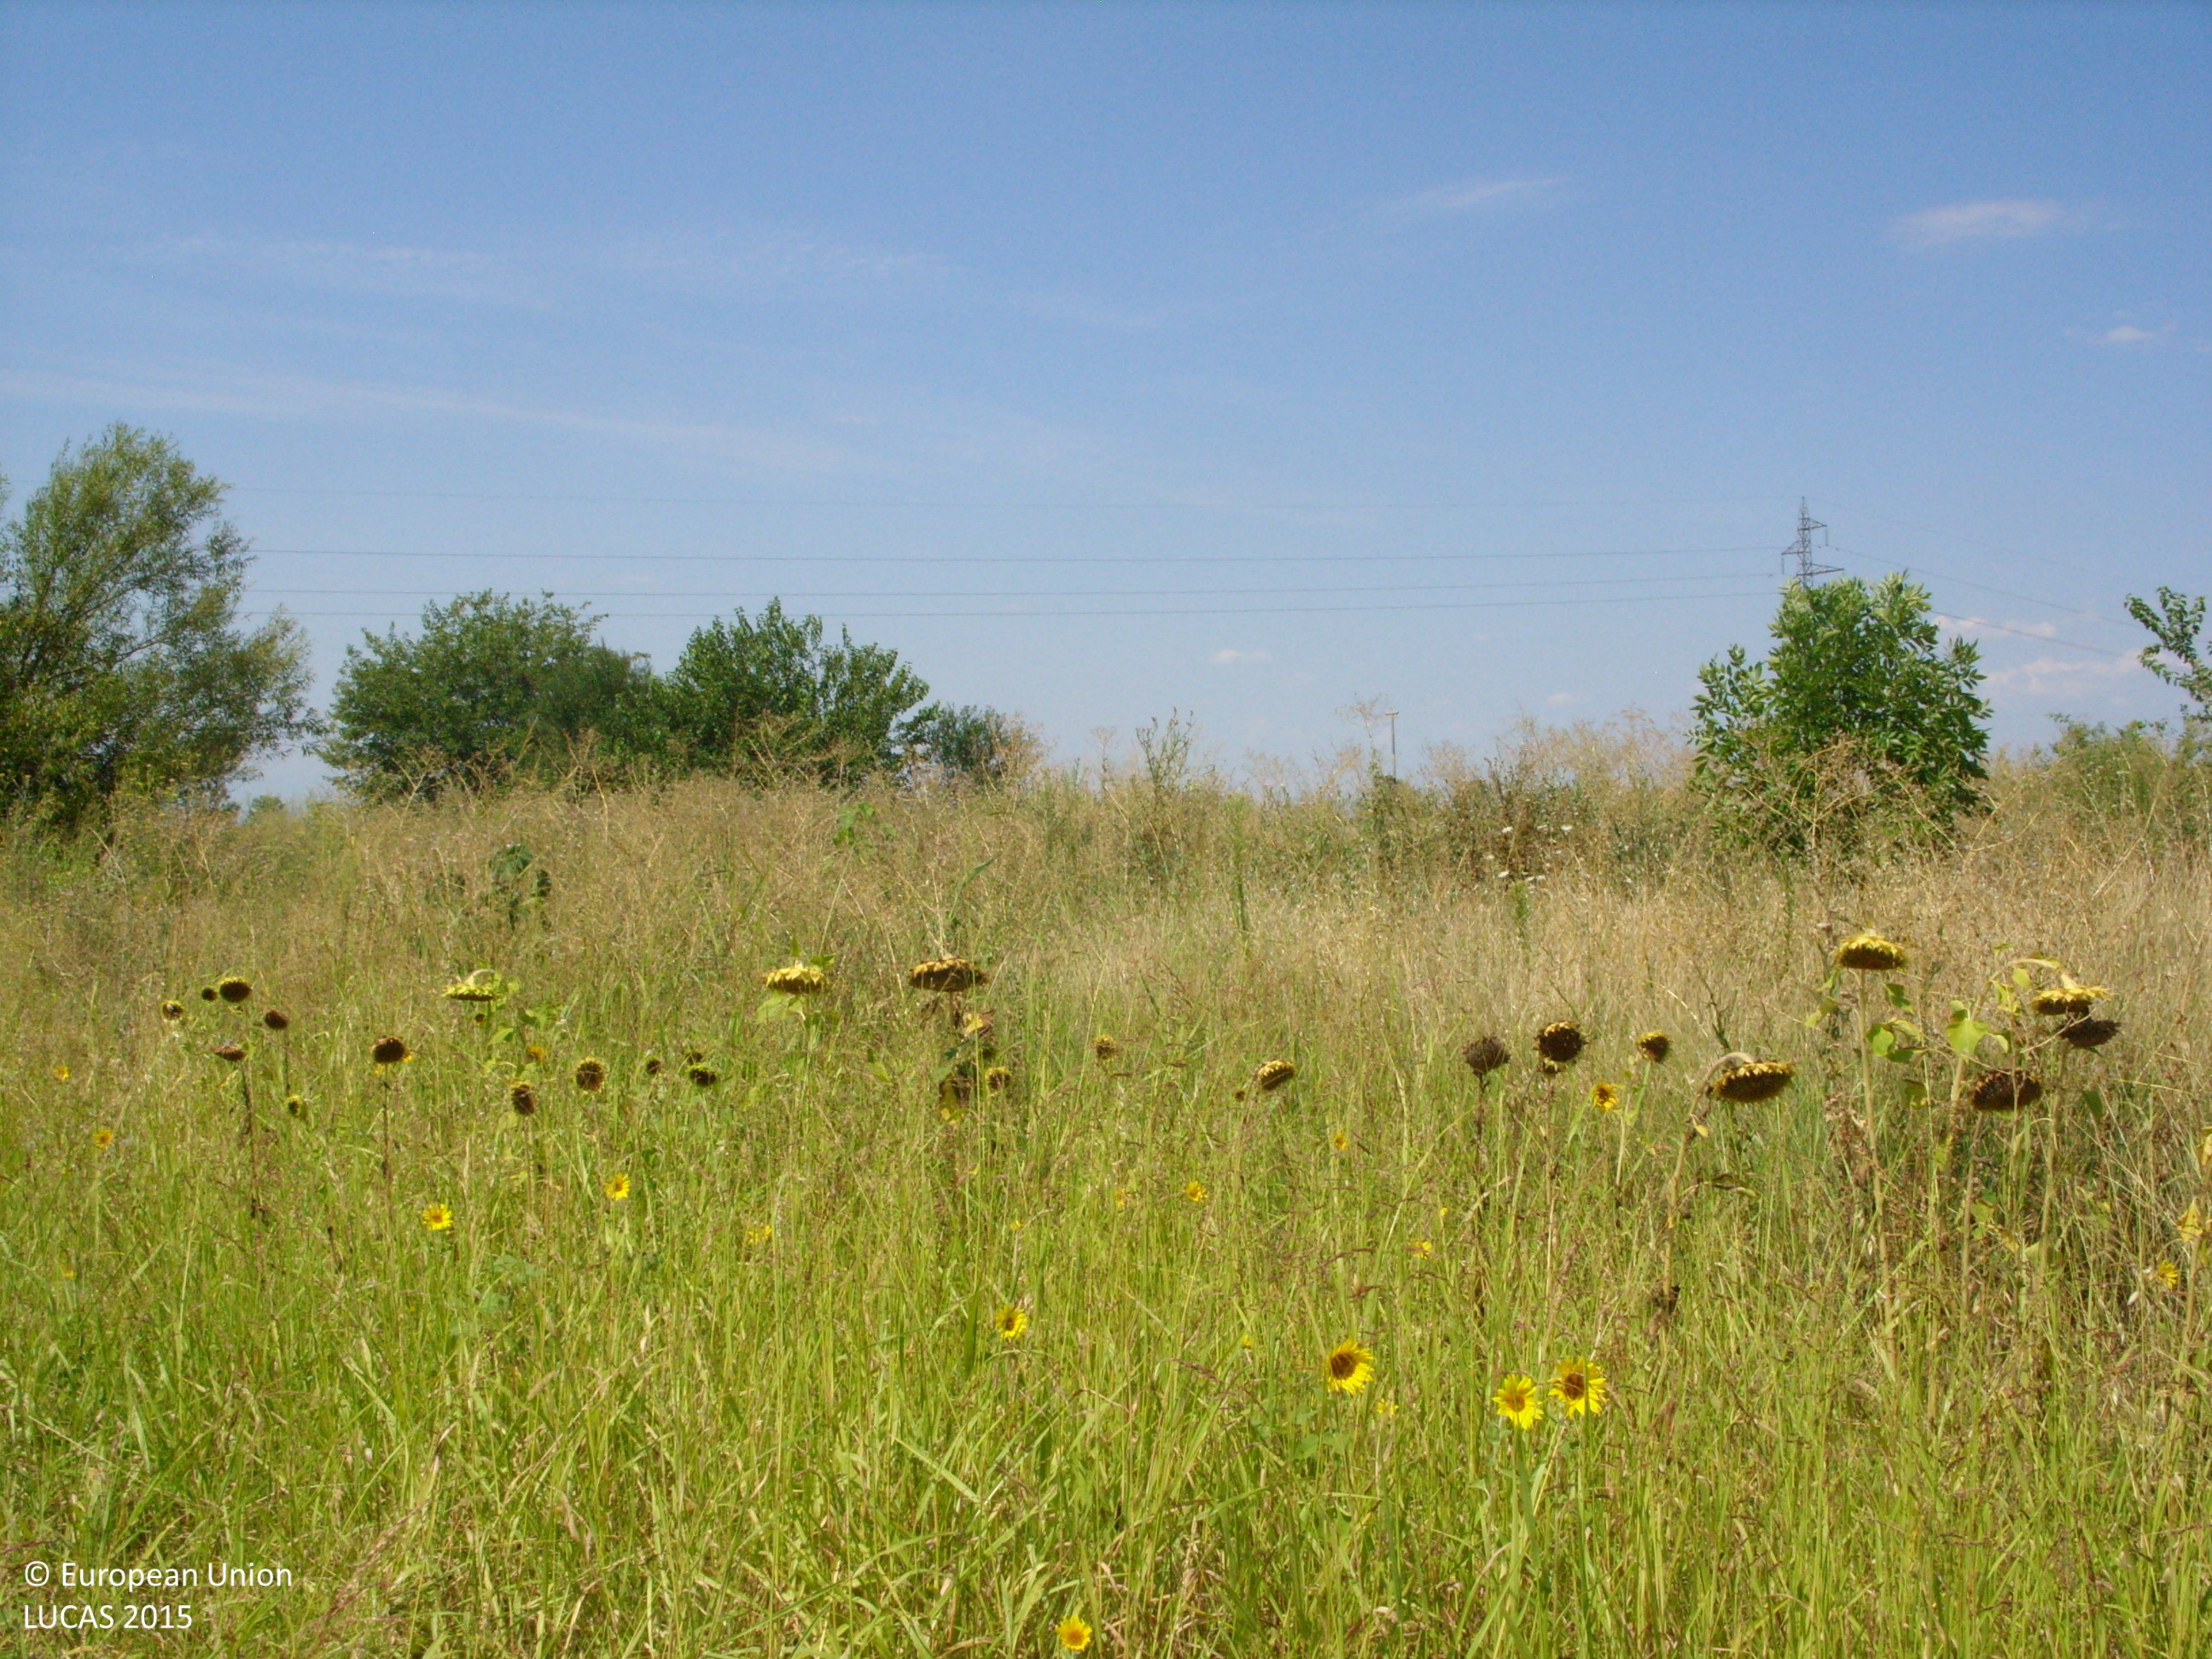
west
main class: Cropland
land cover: Sunflower
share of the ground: > 75 %
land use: Agriculture (excluding fallow land and kitchen gardens)
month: August
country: BG
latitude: 42.3048
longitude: 24.5954
